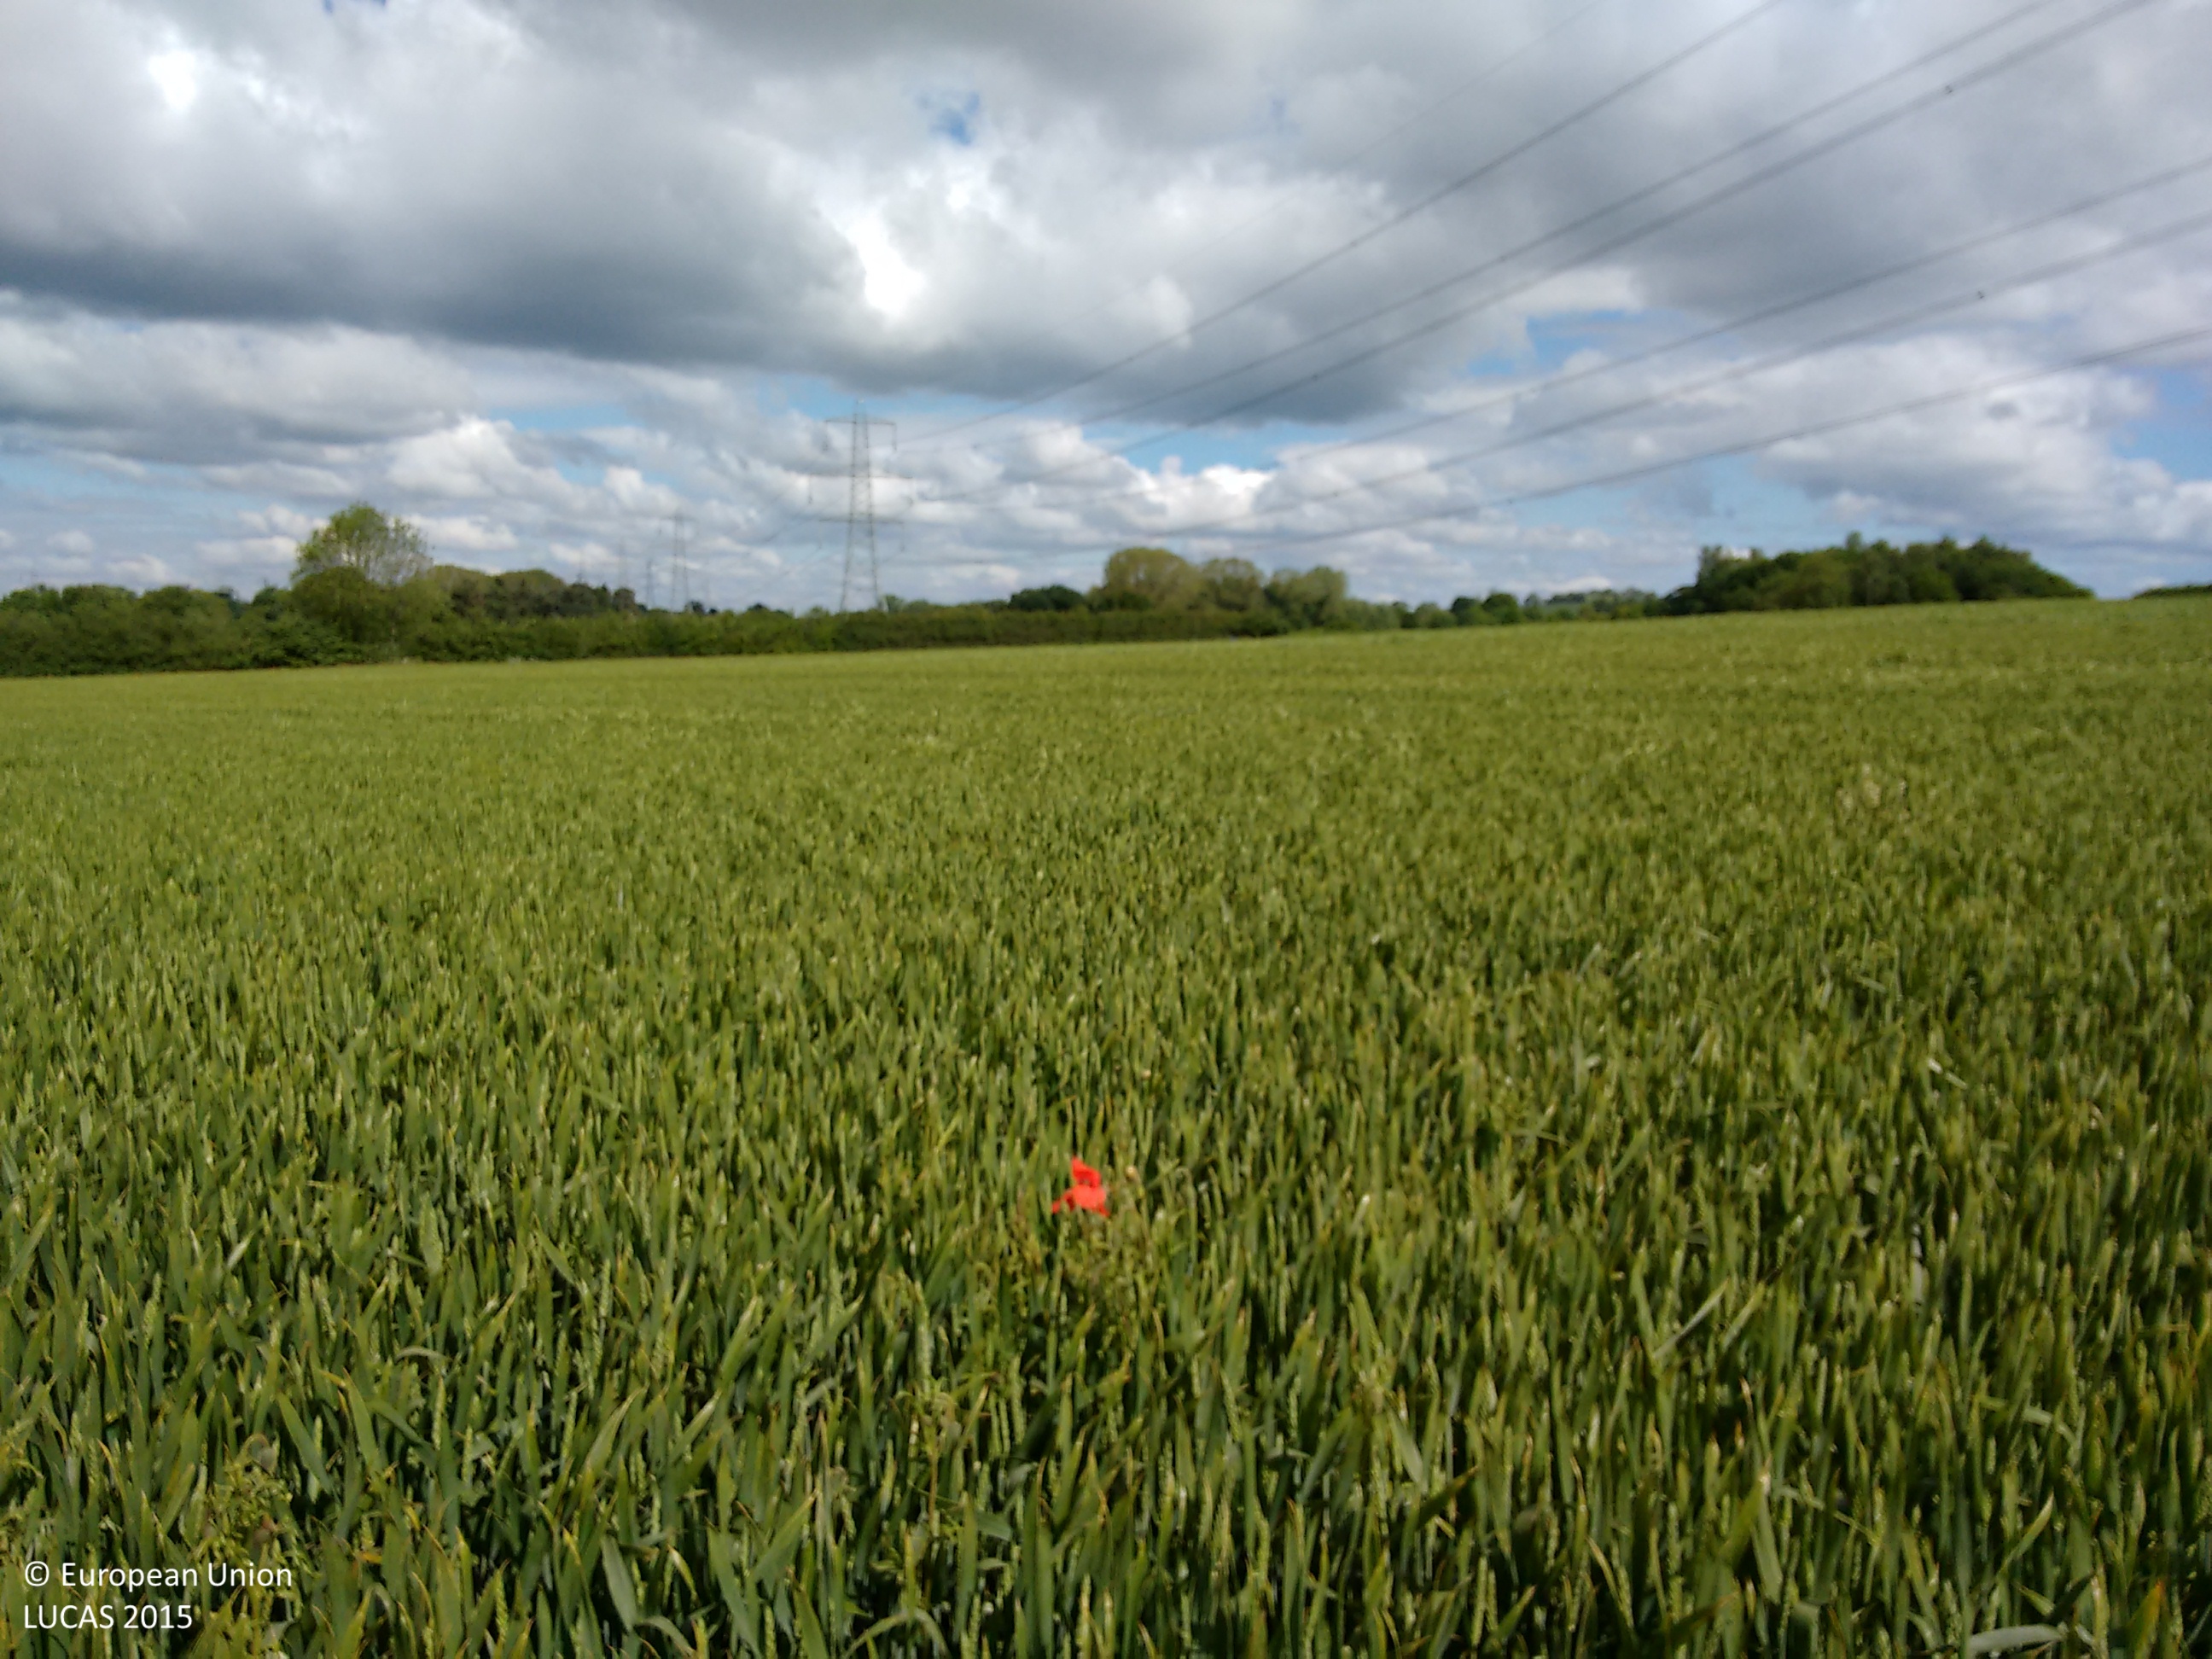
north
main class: Cropland
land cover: Common wheat
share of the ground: > 75 %
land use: Agriculture (excluding fallow land and kitchen gardens)
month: June
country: GB
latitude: 54.1184
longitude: -1.1671
